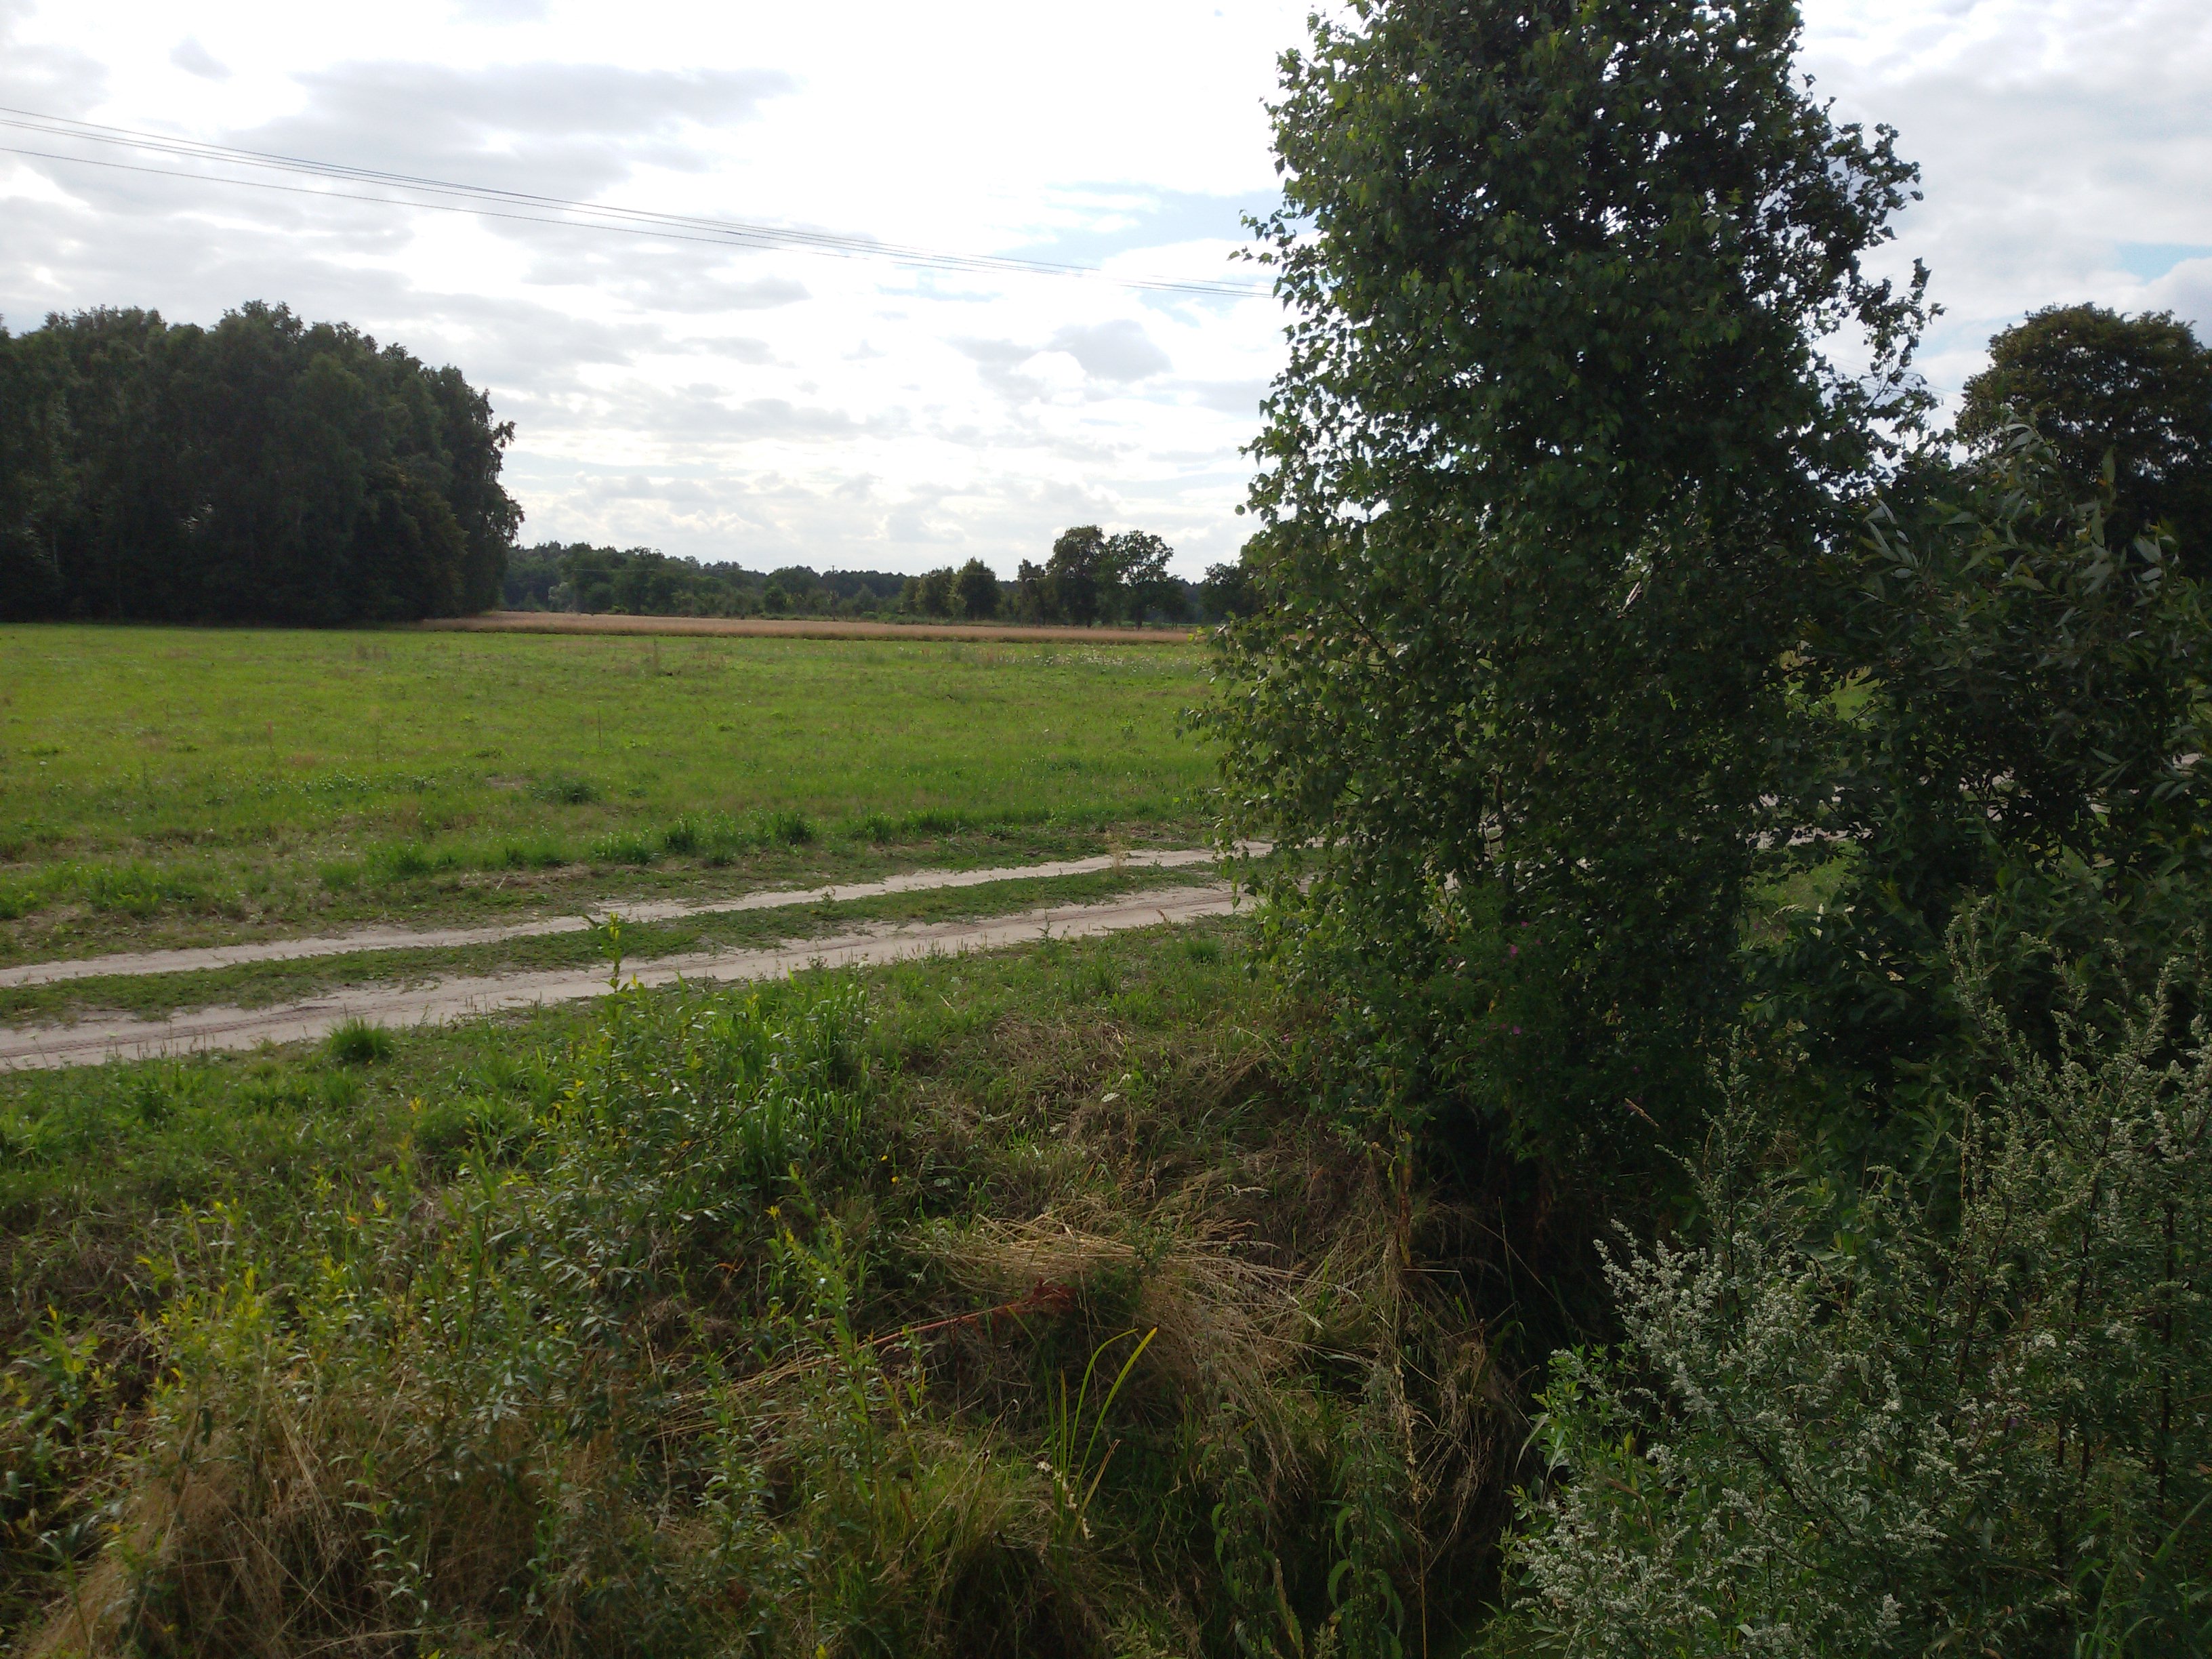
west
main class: Cropland
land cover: Triticale
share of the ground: > 75 %
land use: Agriculture (excluding fallow land and kitchen gardens)
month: July
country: PL
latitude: 52.8384
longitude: 17.0017
